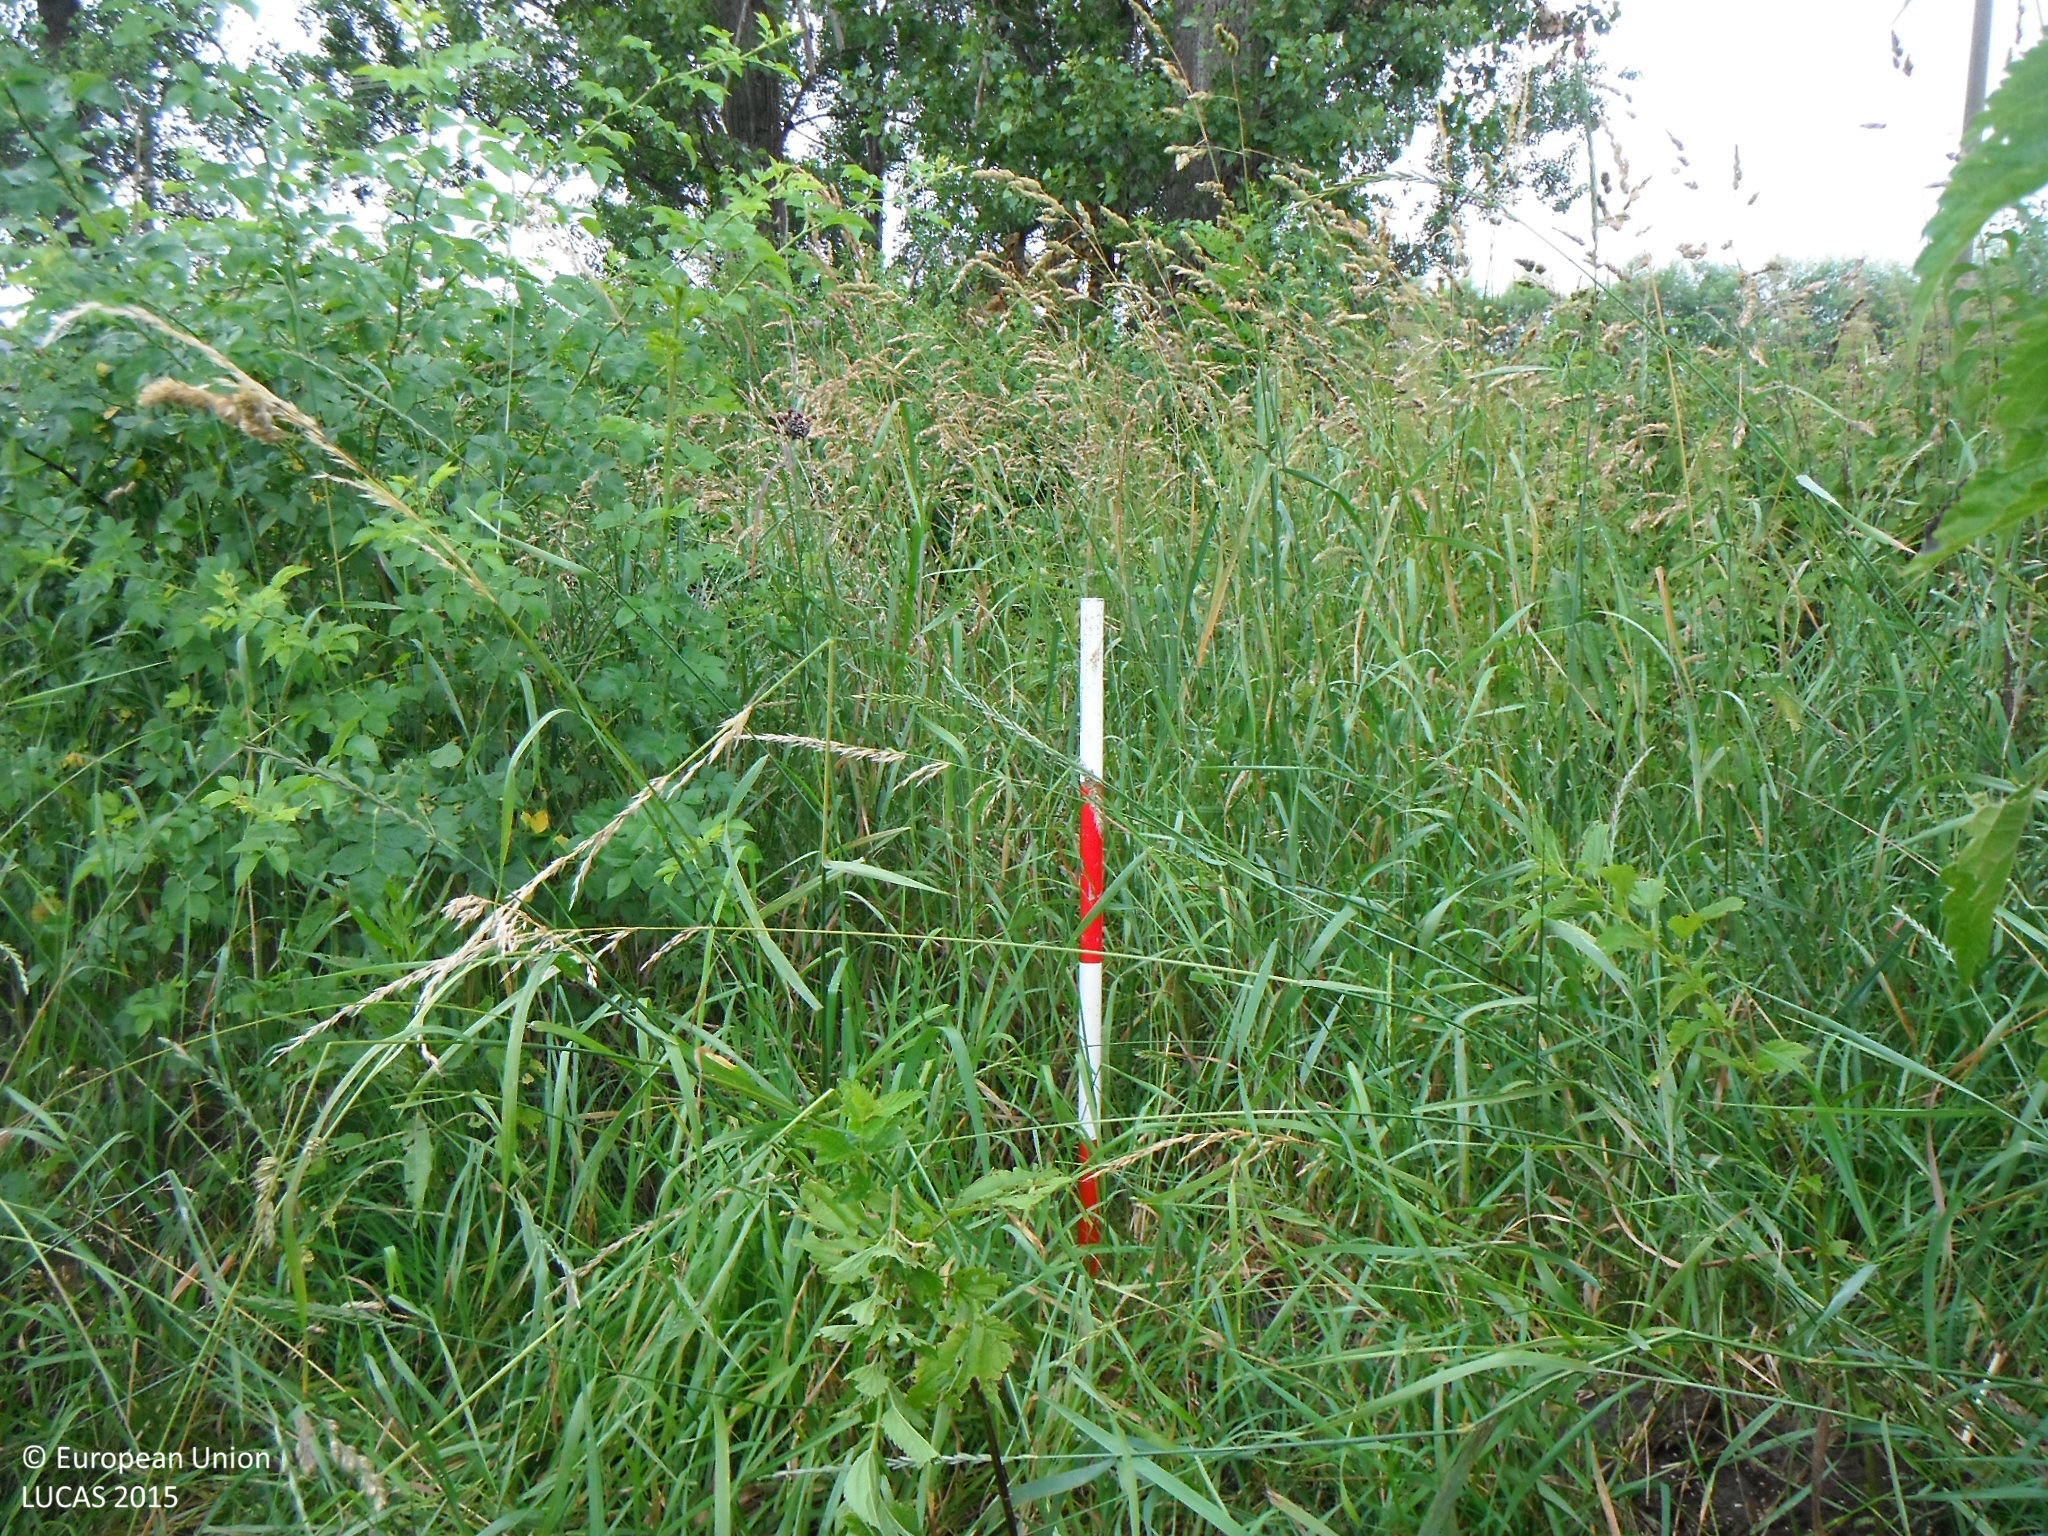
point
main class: Grassland
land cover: Grassland with sparse tree/shrub cover
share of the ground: > 75 %
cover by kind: herbaceous plants 85 %, shrubs 10 %, broadleaved forest trees 5 %
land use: Semi-natural and natural areas not in use
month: June
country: SK
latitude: 48.4903
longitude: 20.0293
